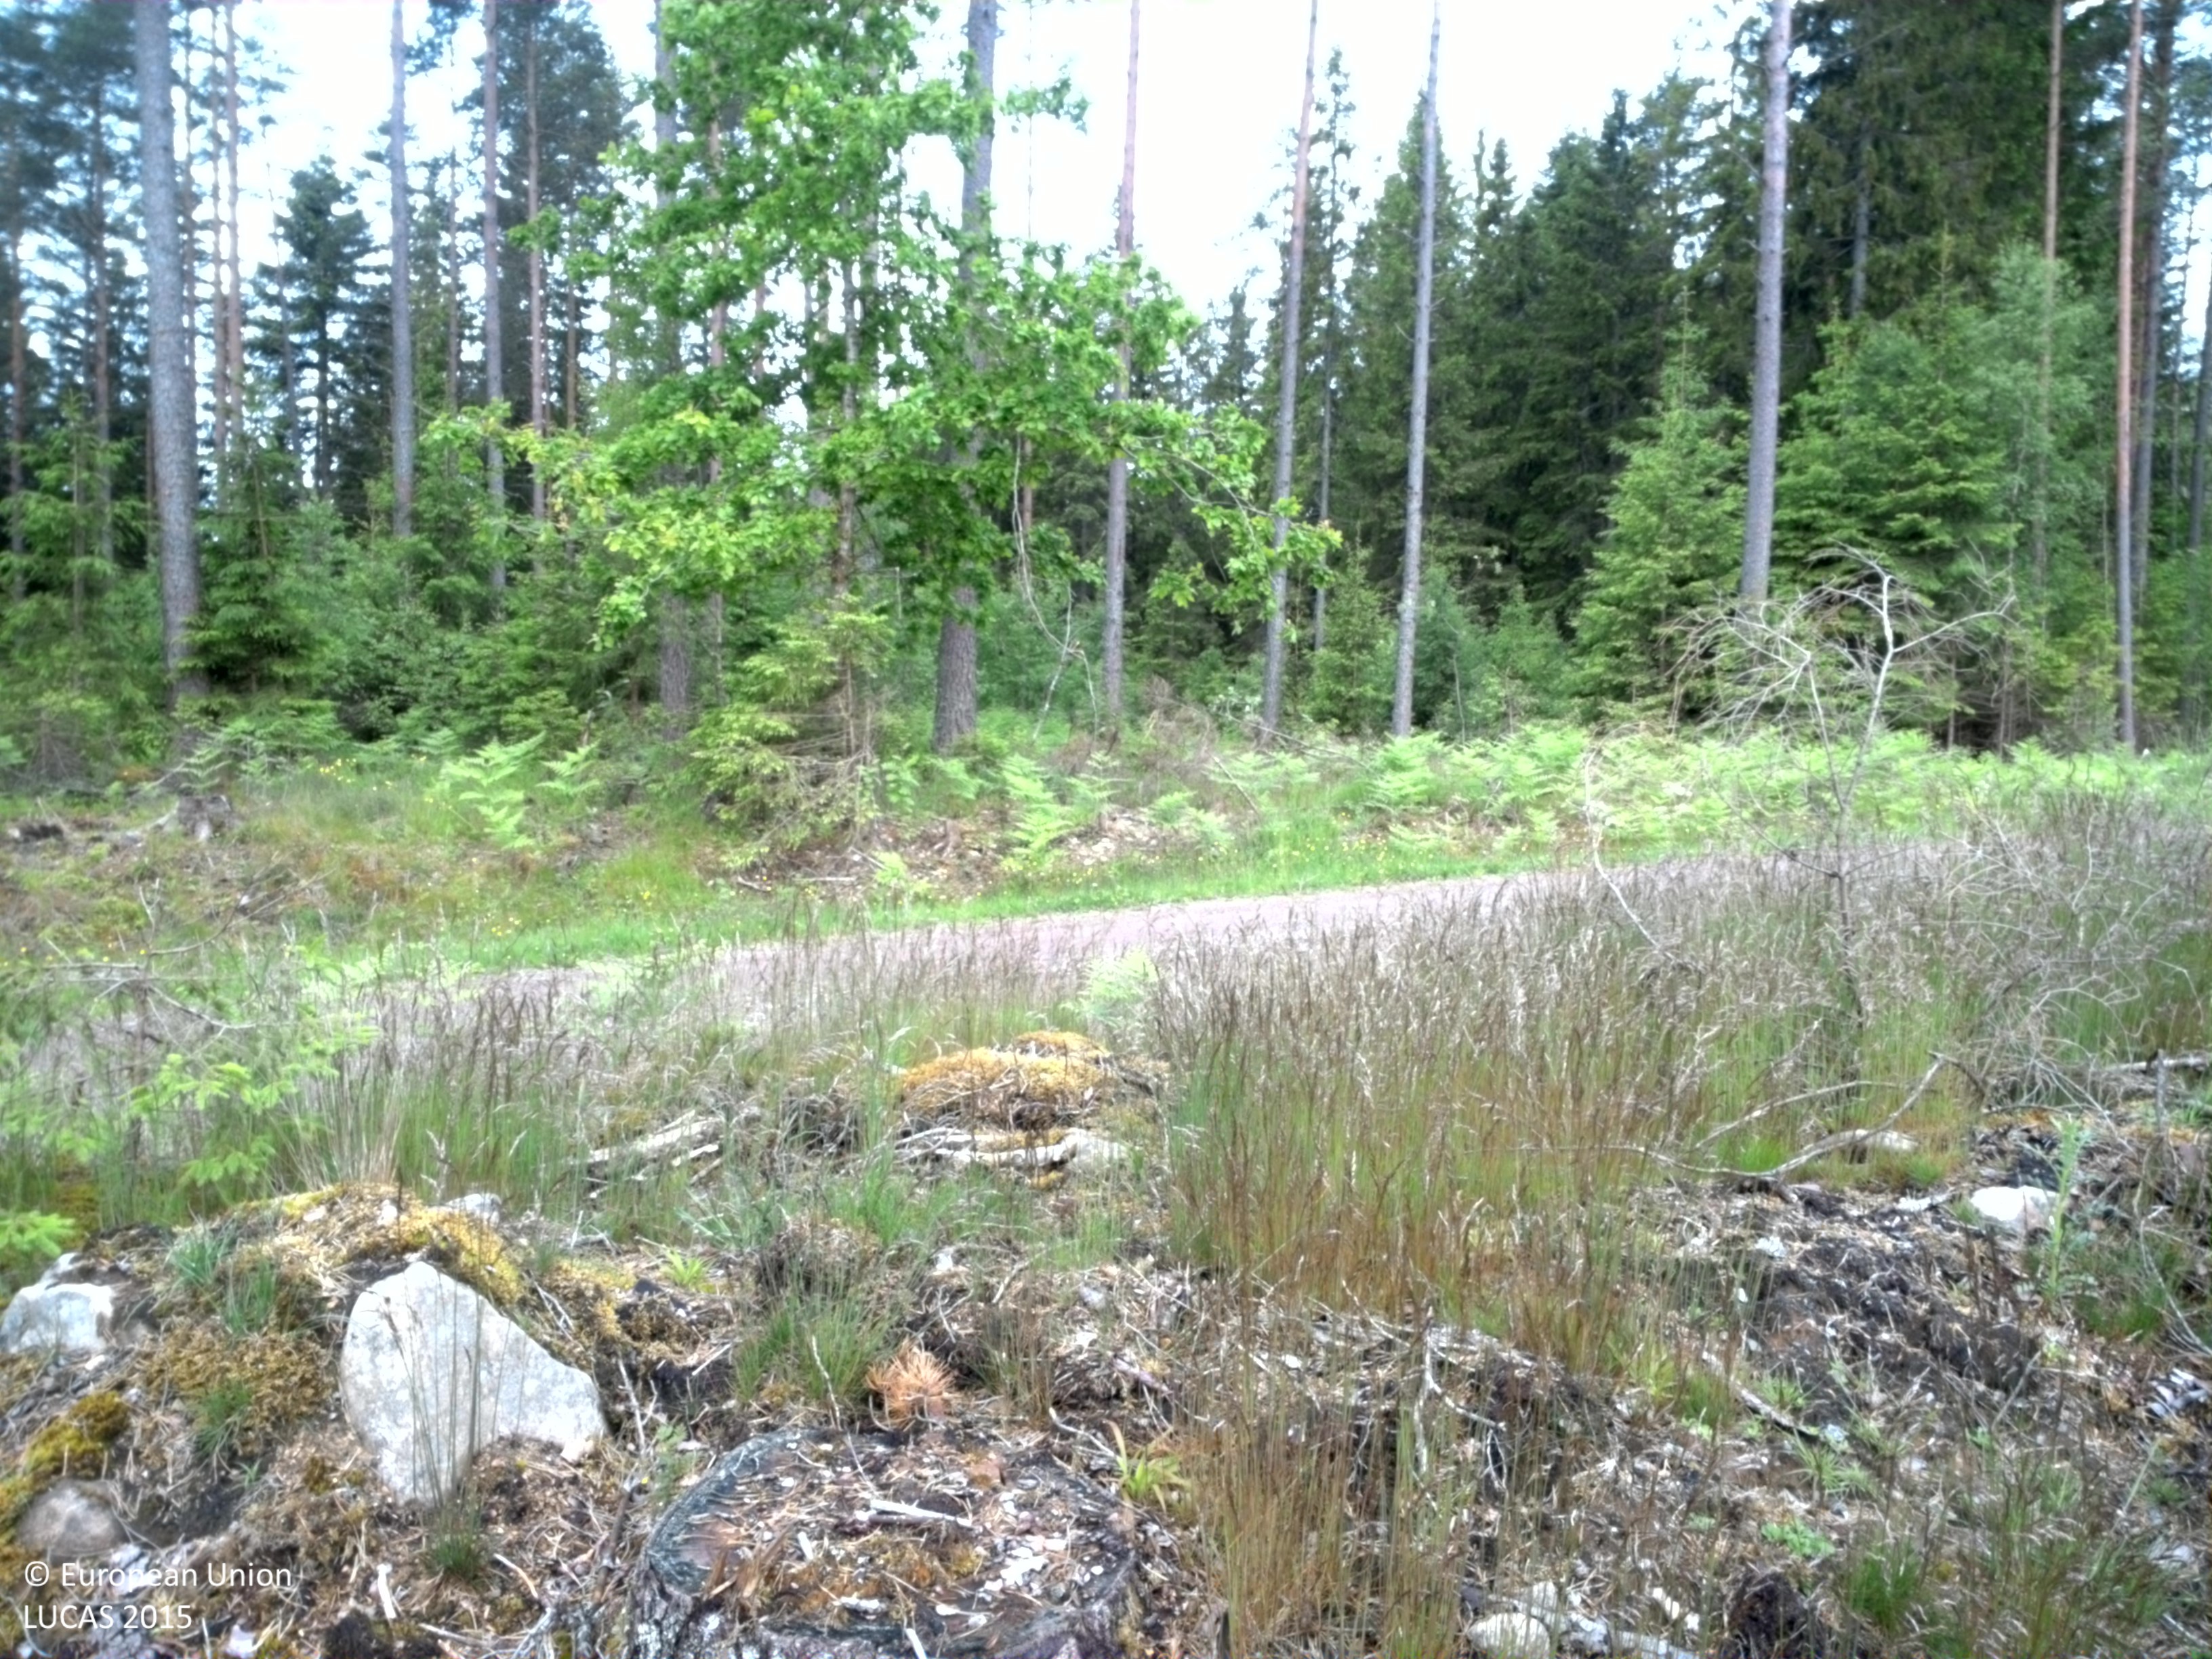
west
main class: Grassland
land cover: Spontaneously vegetated surfaces
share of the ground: 25 - 50 %
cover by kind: herbaceous plants 40 %, lichens and mosses 40 %, unconsolidated bare surface 10 %
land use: Forestry
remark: Clear cut
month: June
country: SE
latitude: 57.5520
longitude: 13.8556
